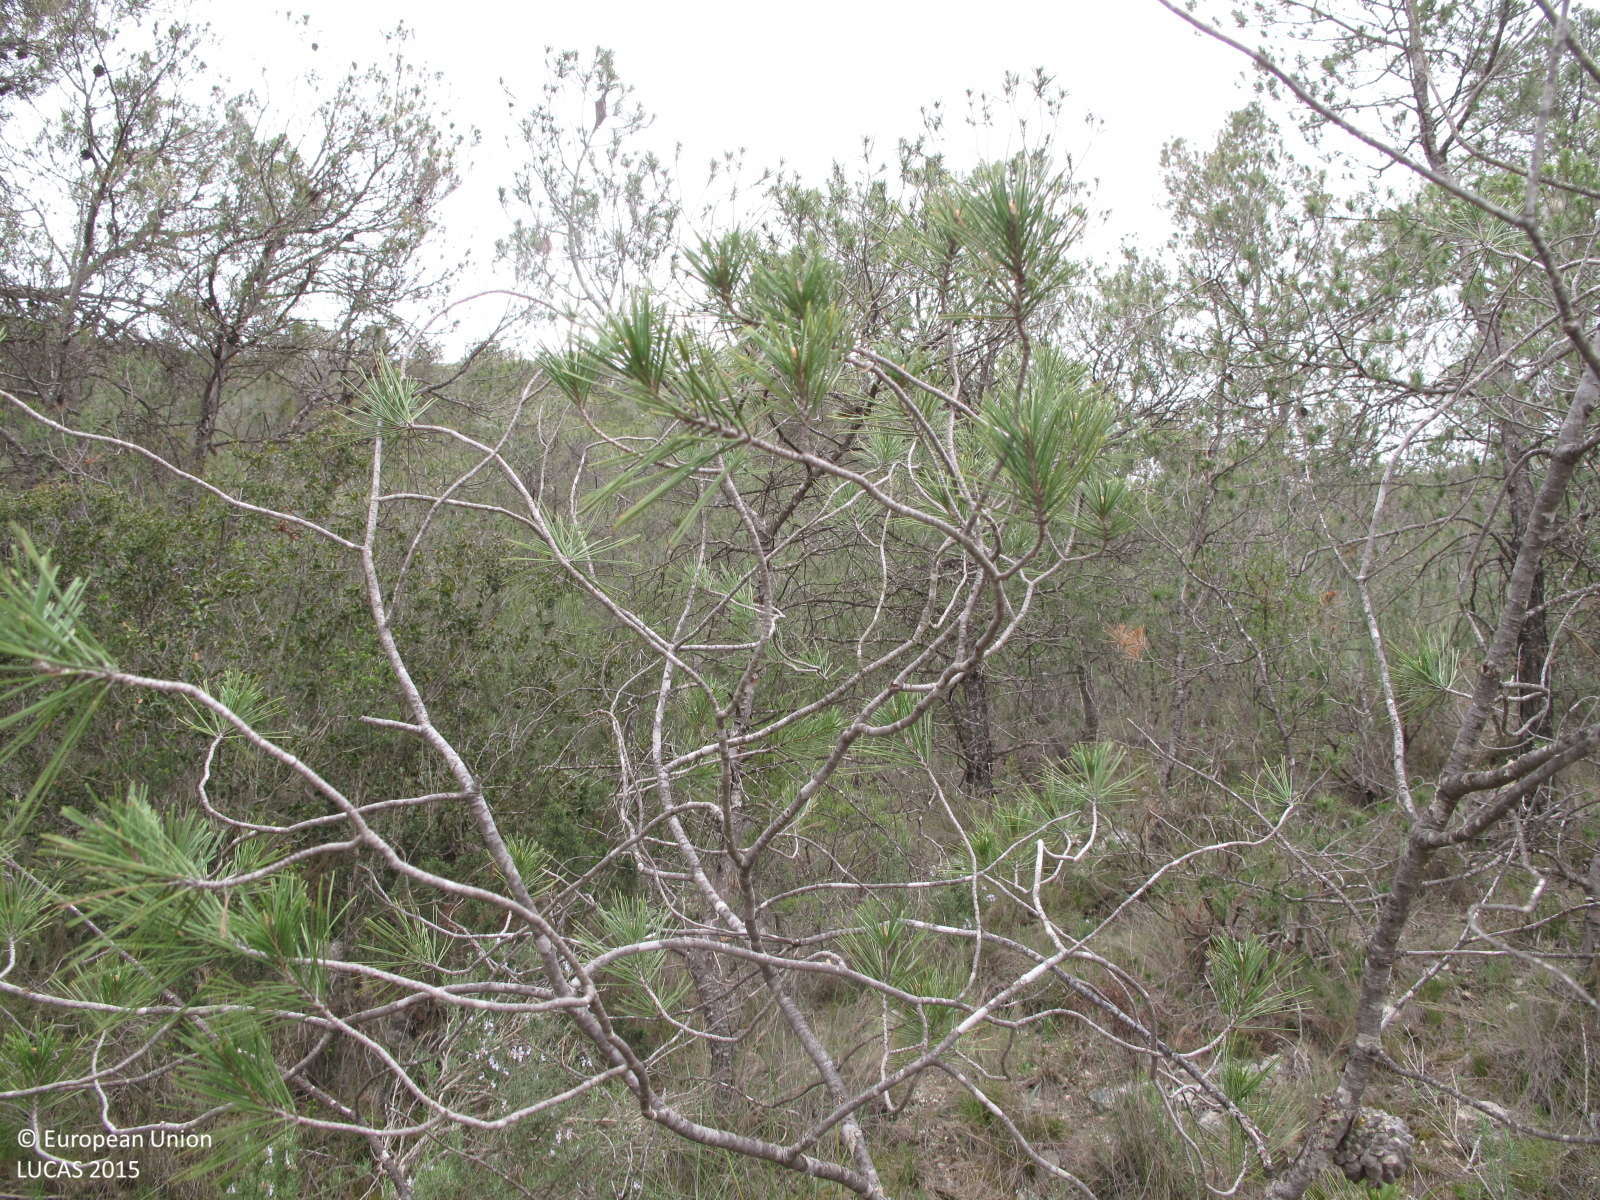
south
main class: Woodland
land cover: Pine dominated coniferous woodland
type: coniferous forest of the mediterranean region
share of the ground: 50 - 75 %
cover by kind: coniferous forest trees 60 %, shrubs 20 %, herbaceous plants 20 %
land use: Semi-natural and natural areas not in use
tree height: > 5 m
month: April
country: ES
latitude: 38.6111
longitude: -0.9577
